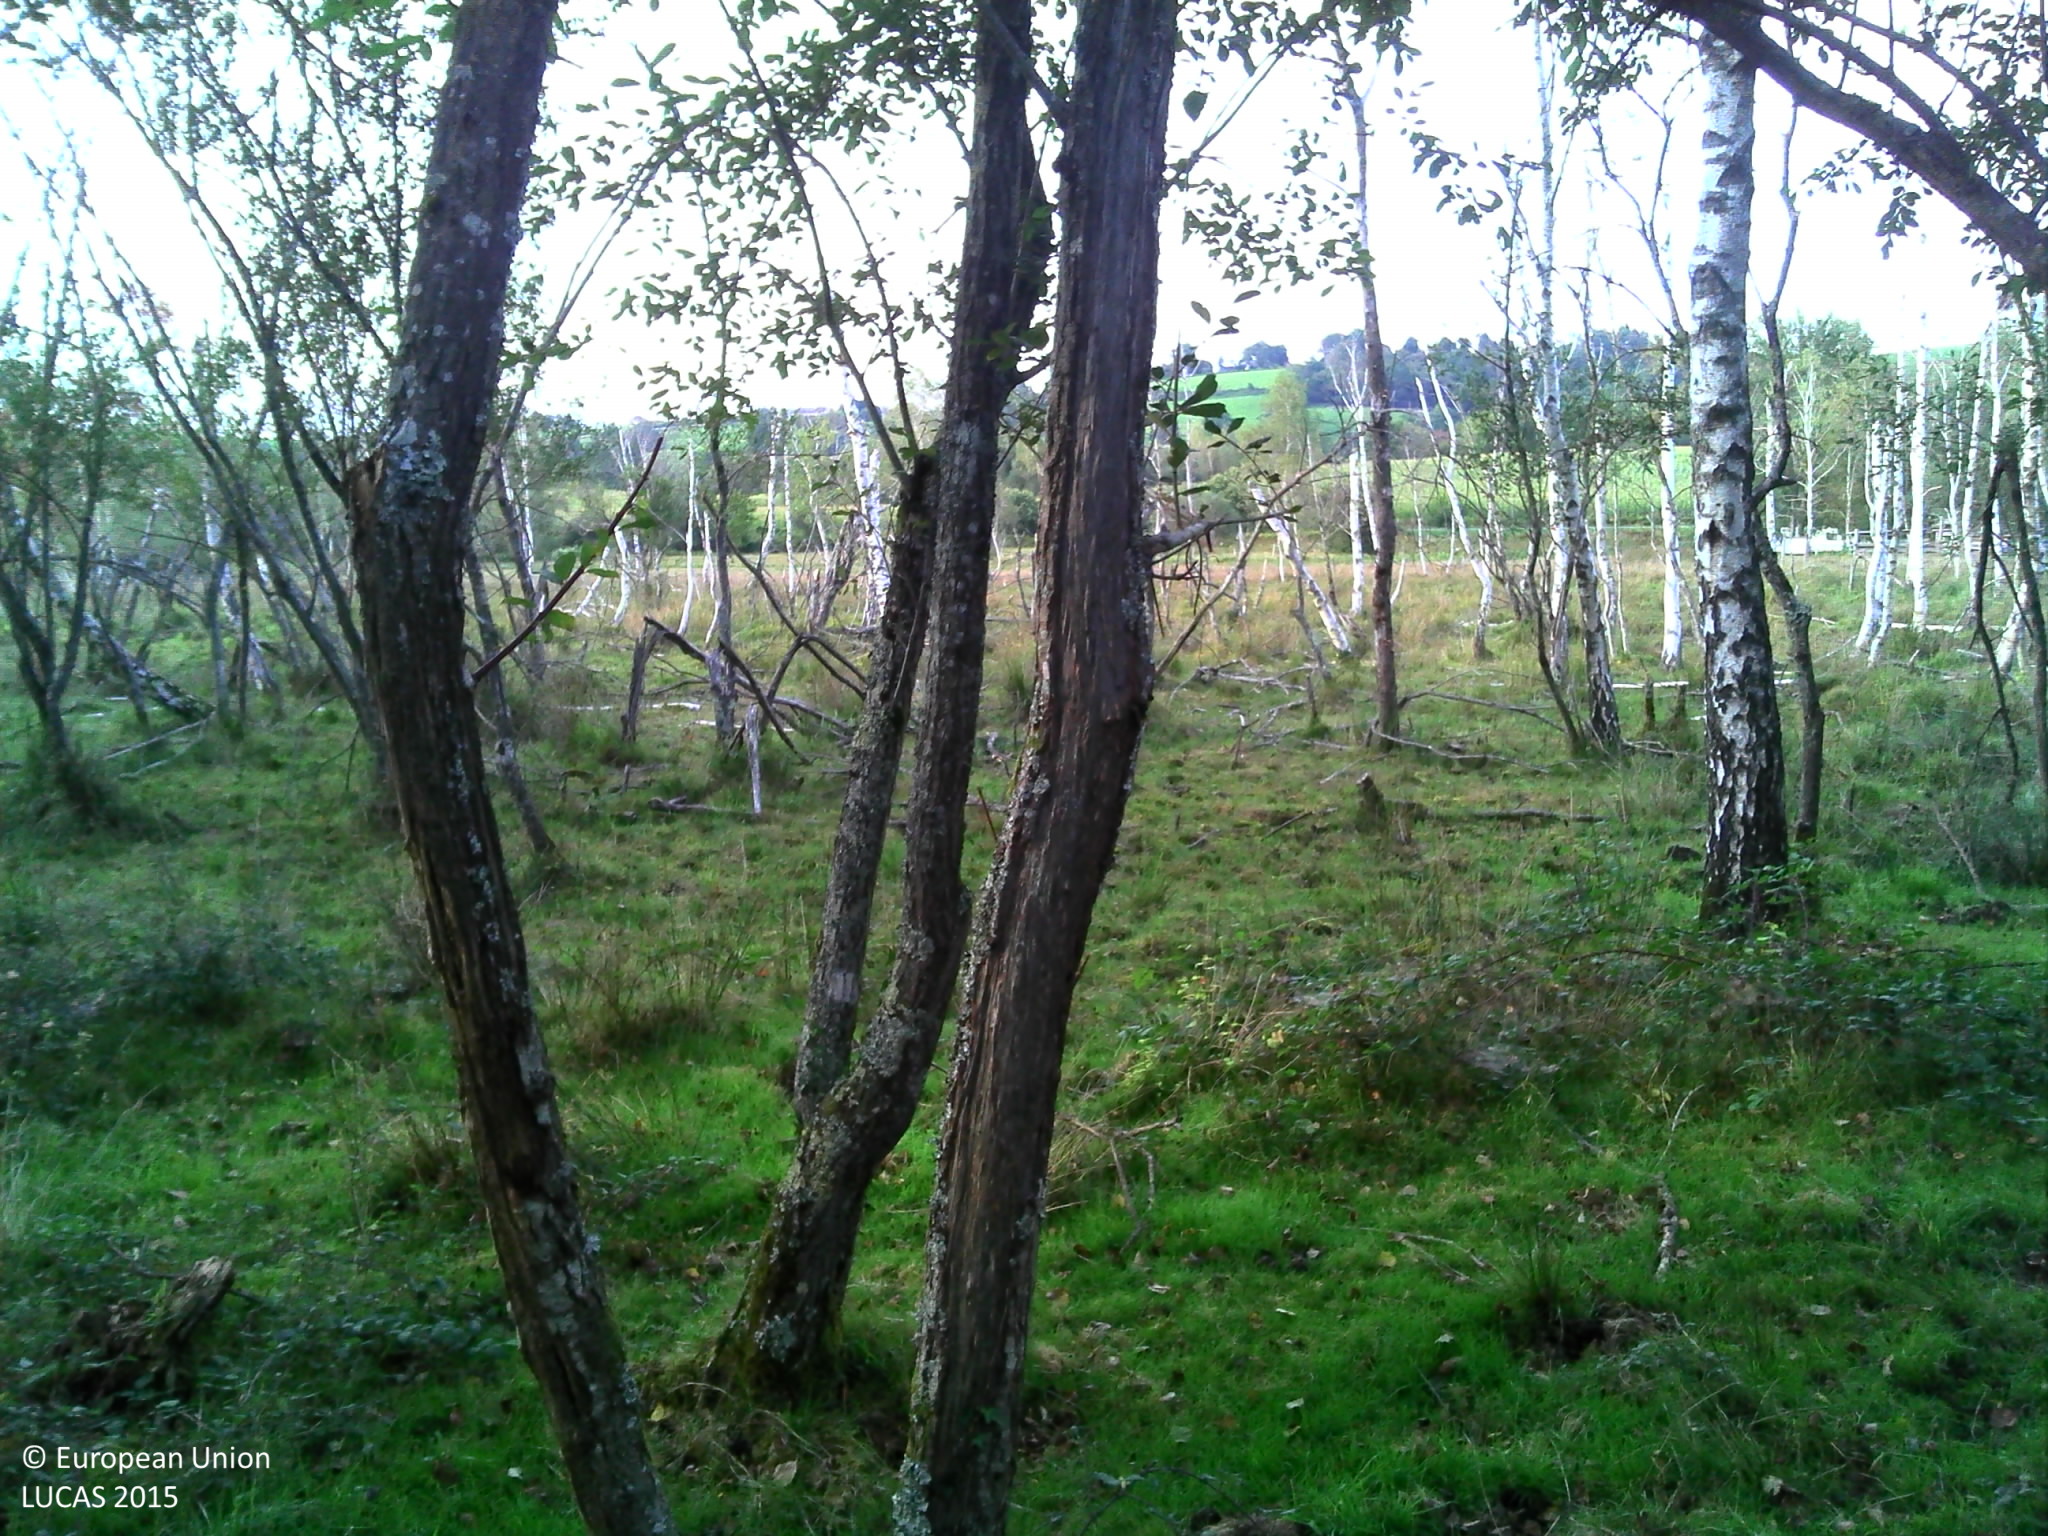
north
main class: Woodland
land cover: Broadleaved woodland
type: exotic forest
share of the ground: 50 - 75 %
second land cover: Grassland without tree/shrub cover
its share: > 75 %
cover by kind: broadleaved forest trees 55 %, herbaceous plants 40 %, lichens and mosses 5 %
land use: Forestry
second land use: Agriculture (excluding fallow land and kitchen gardens)
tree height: > 5 m
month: September
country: FR
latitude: 43.1493
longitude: -0.4461
